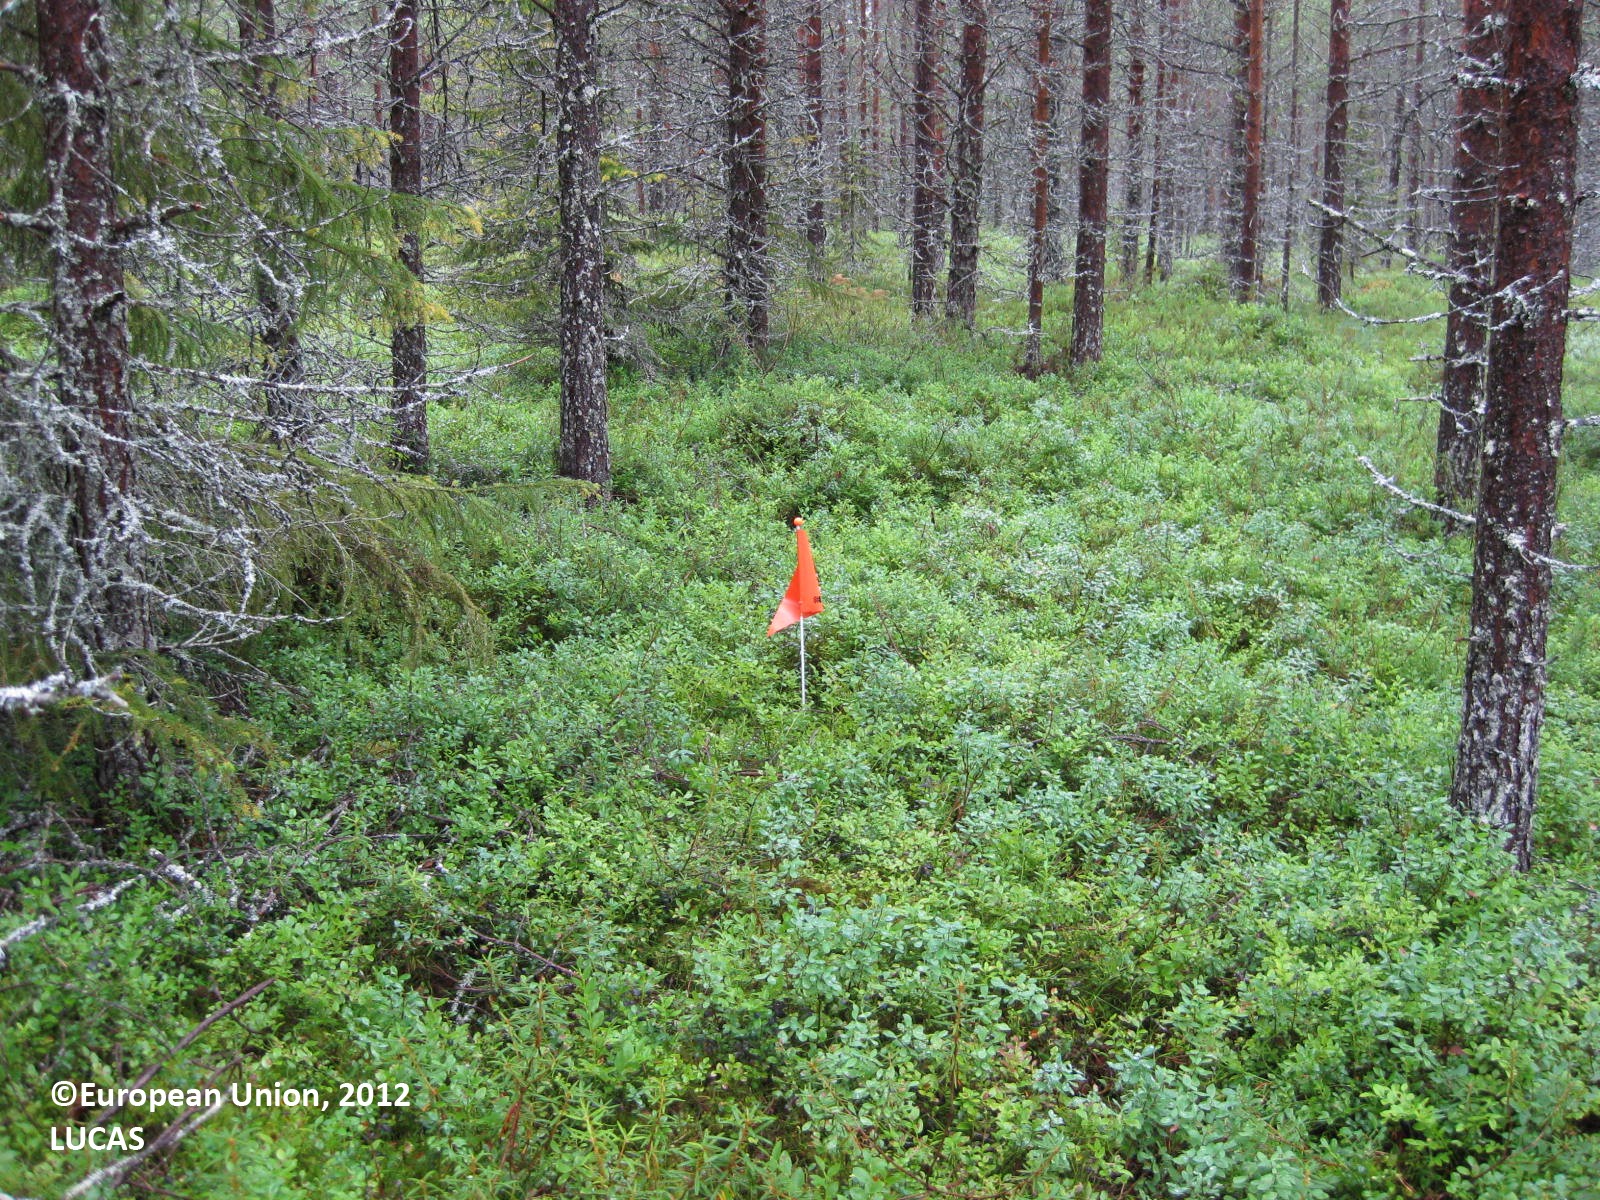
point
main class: Woodland
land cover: Pine dominated coniferous woodland
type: boreal forest
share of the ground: 50 - 75 %
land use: Forestry
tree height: > 5 m
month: August
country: FI
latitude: 65.9885
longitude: 28.3172
